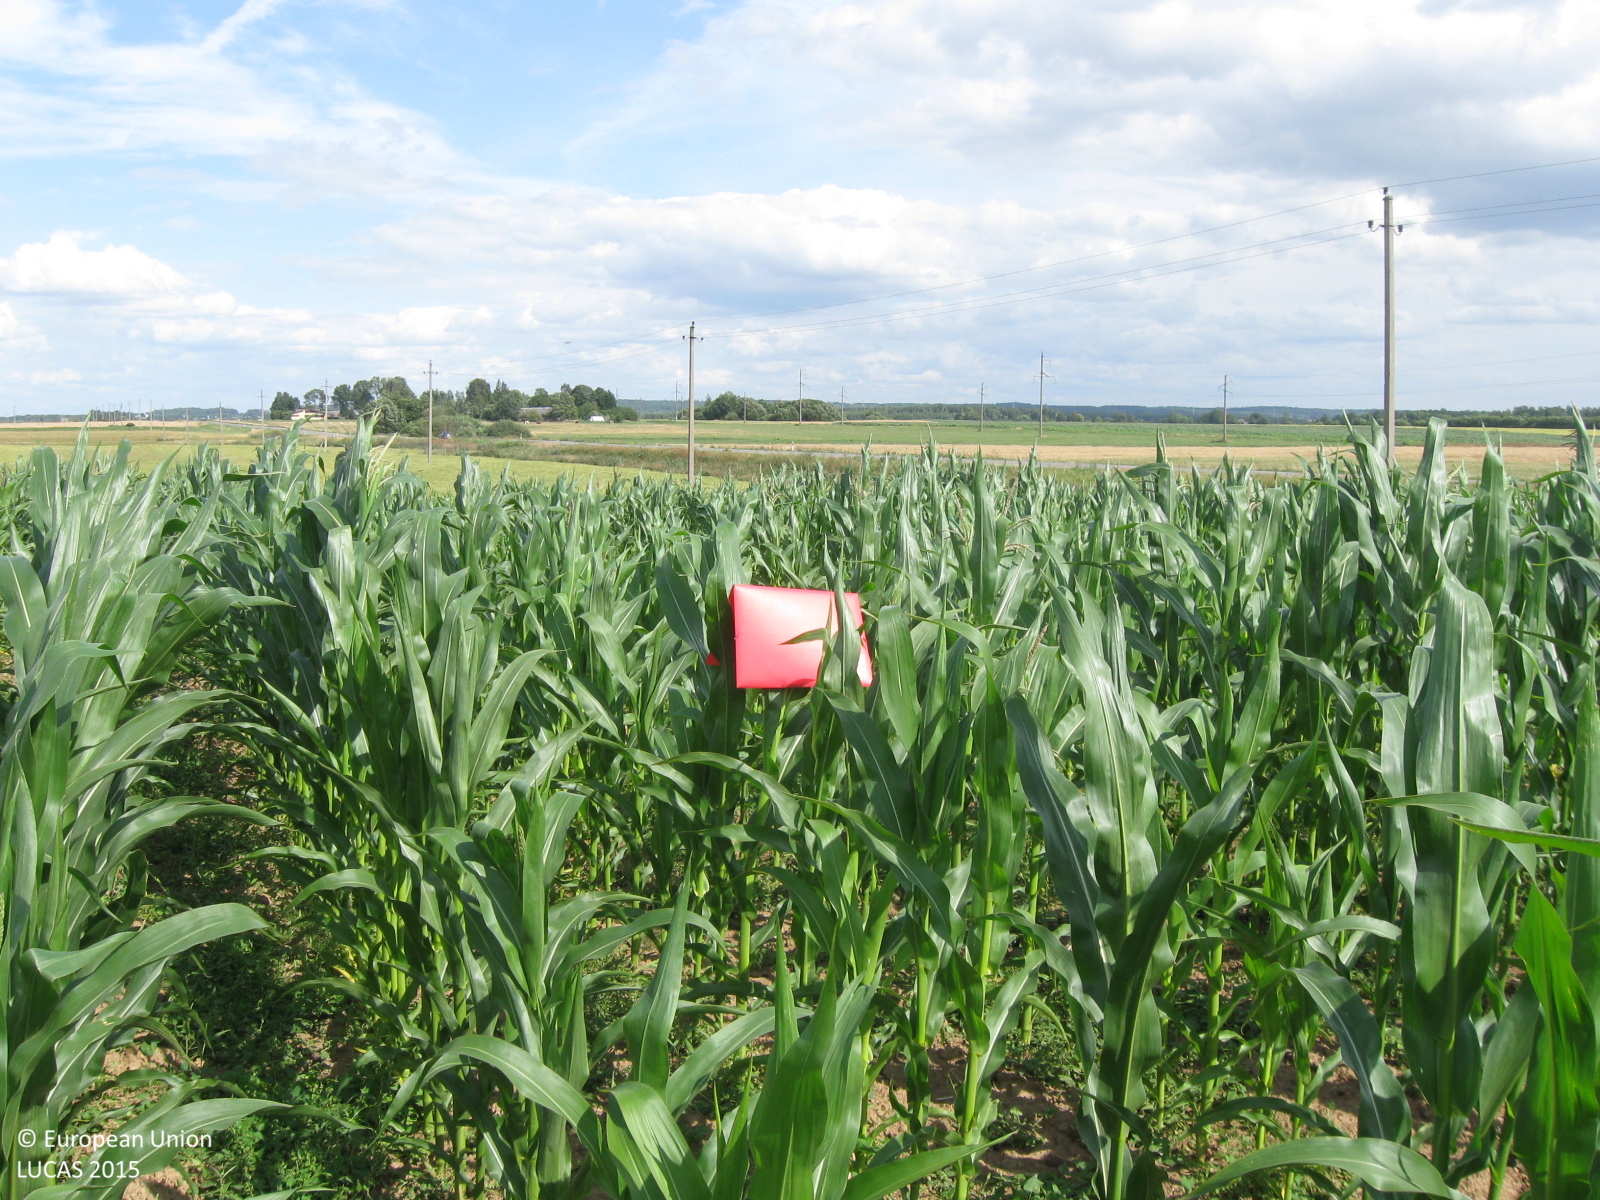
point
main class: Cropland
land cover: Maize
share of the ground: > 75 %
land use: Agriculture (excluding fallow land and kitchen gardens)
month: July
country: LT
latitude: 54.3790
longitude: 23.4605
